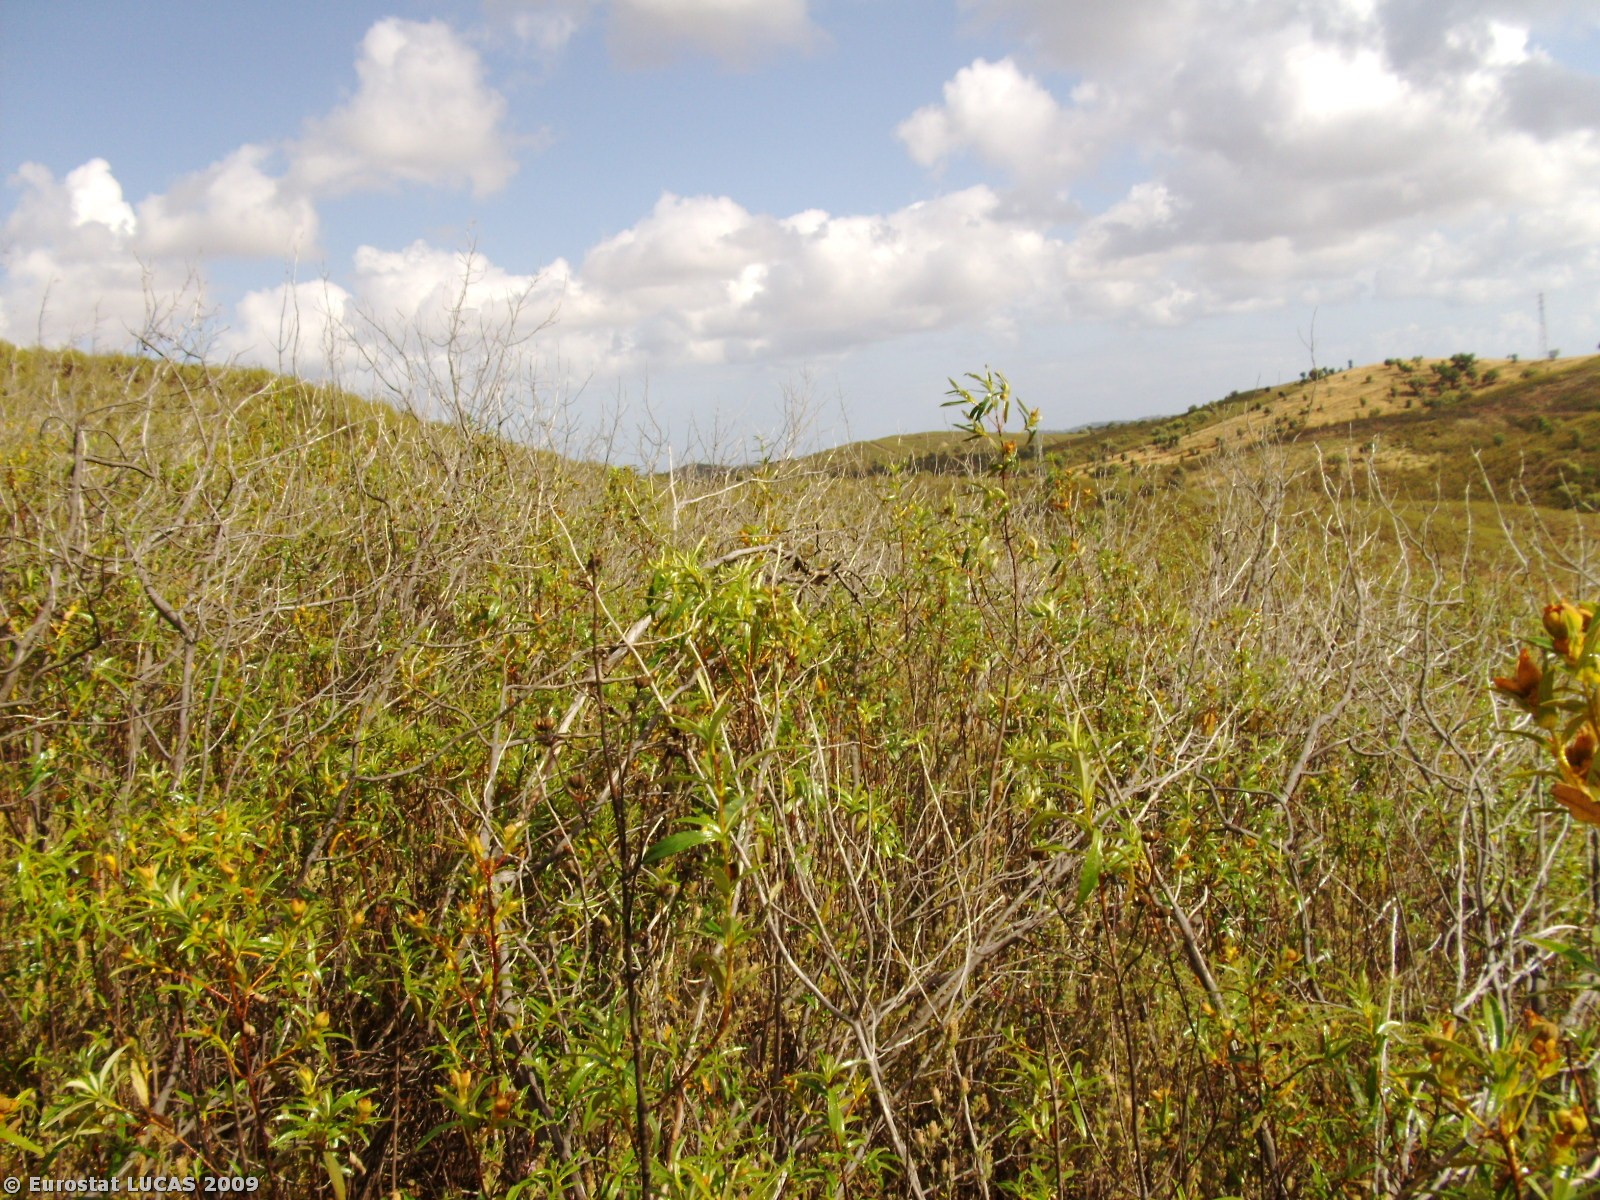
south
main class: Shrubland
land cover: Shrubland without tree cover
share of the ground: > 75 %
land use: Unused
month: June
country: PT
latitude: 37.2050
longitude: -8.7241
